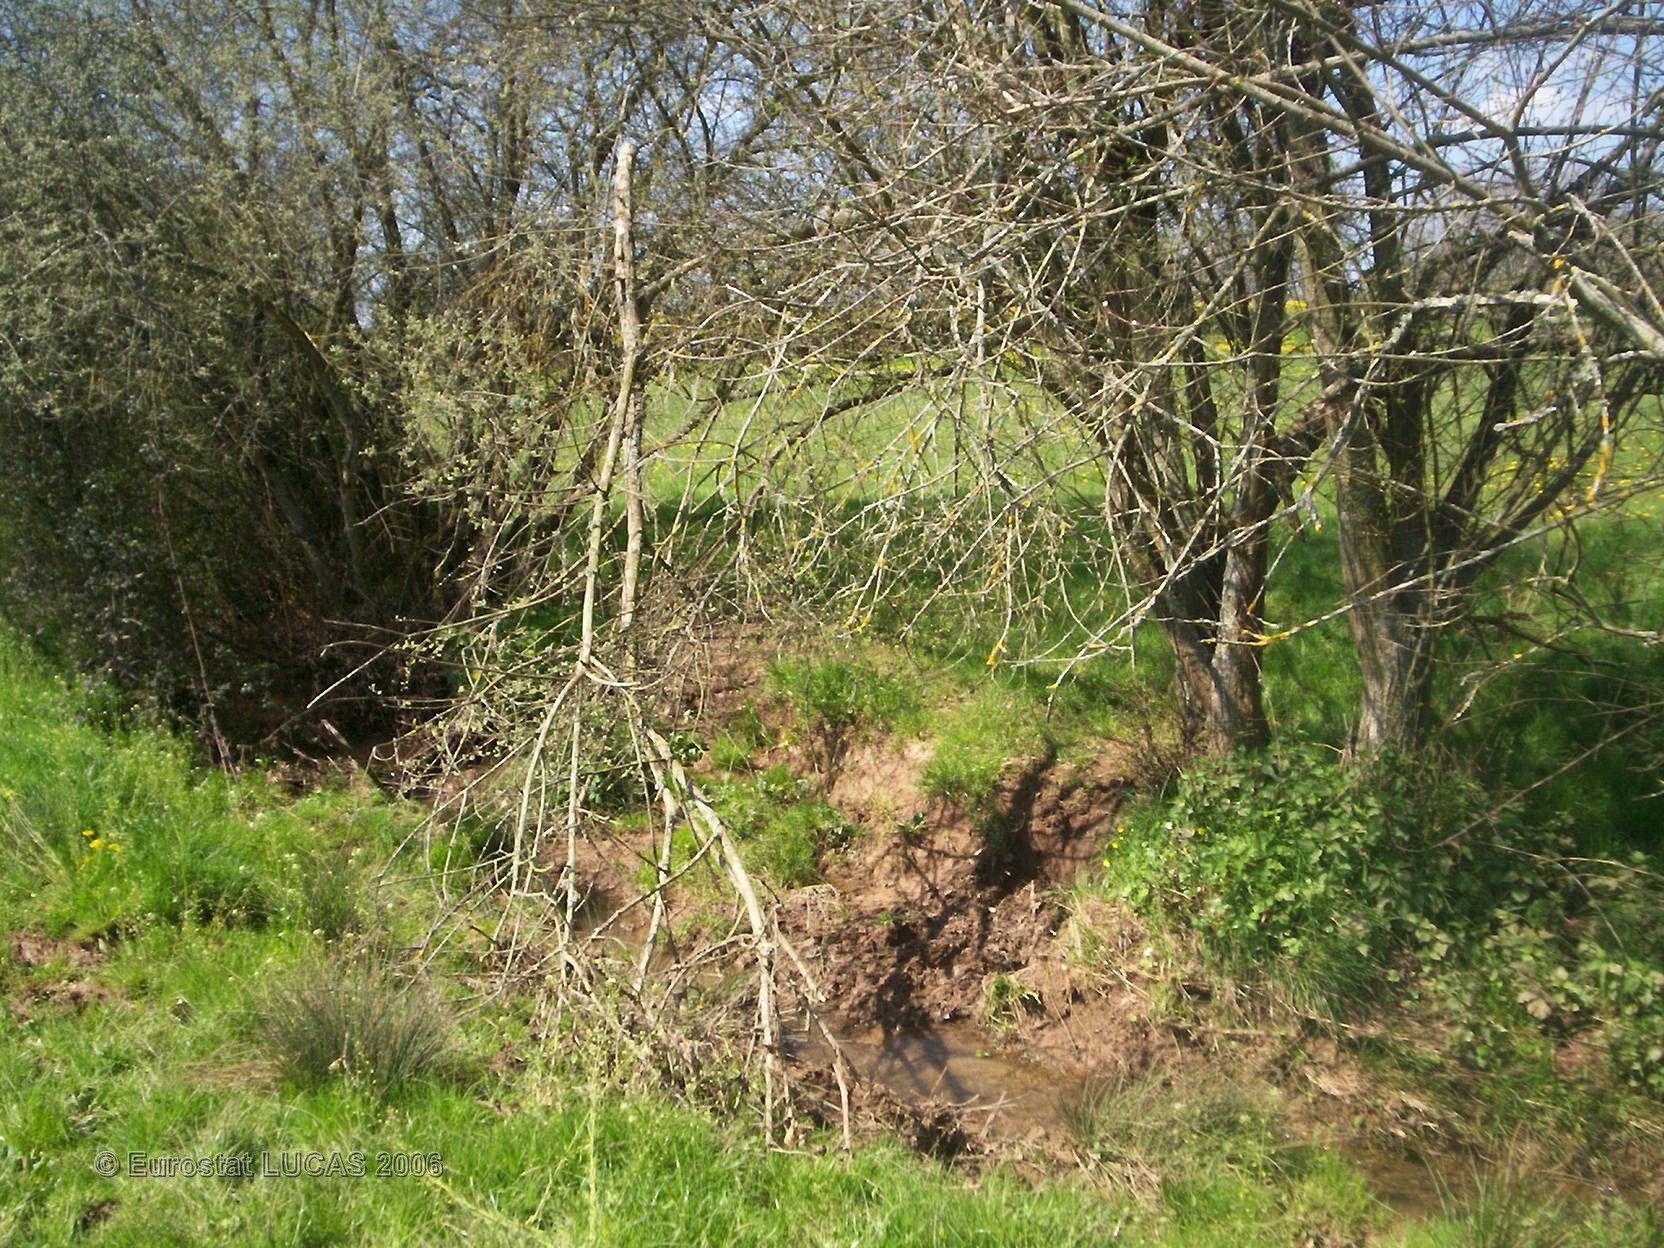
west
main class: Grassland
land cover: Grassland without tree/shrub cover
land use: Agriculture (excluding fallow land and kitchen gardens)
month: April
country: FR
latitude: 46.6335
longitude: 3.0871
